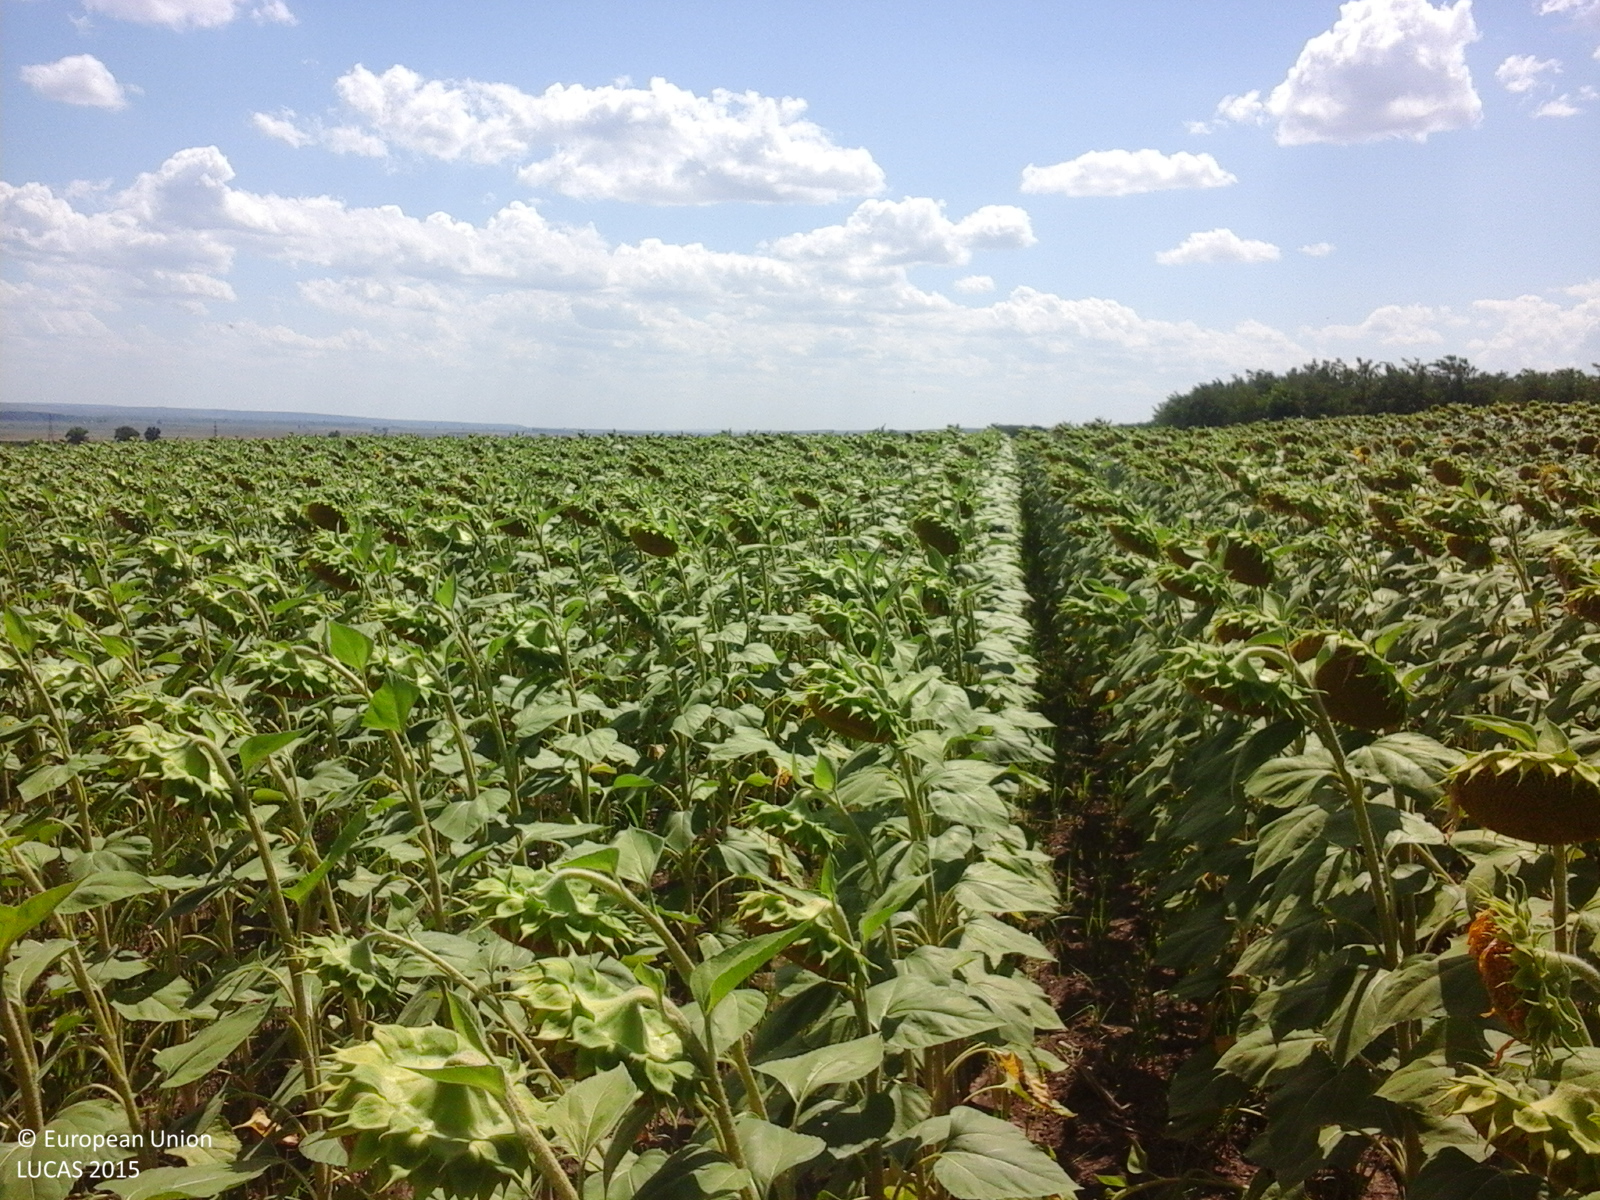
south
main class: Cropland
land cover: Sunflower
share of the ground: > 75 %
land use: Agriculture (excluding fallow land and kitchen gardens)
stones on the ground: < 10 %
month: July
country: RO
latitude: 46.4356
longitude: 28.1836
